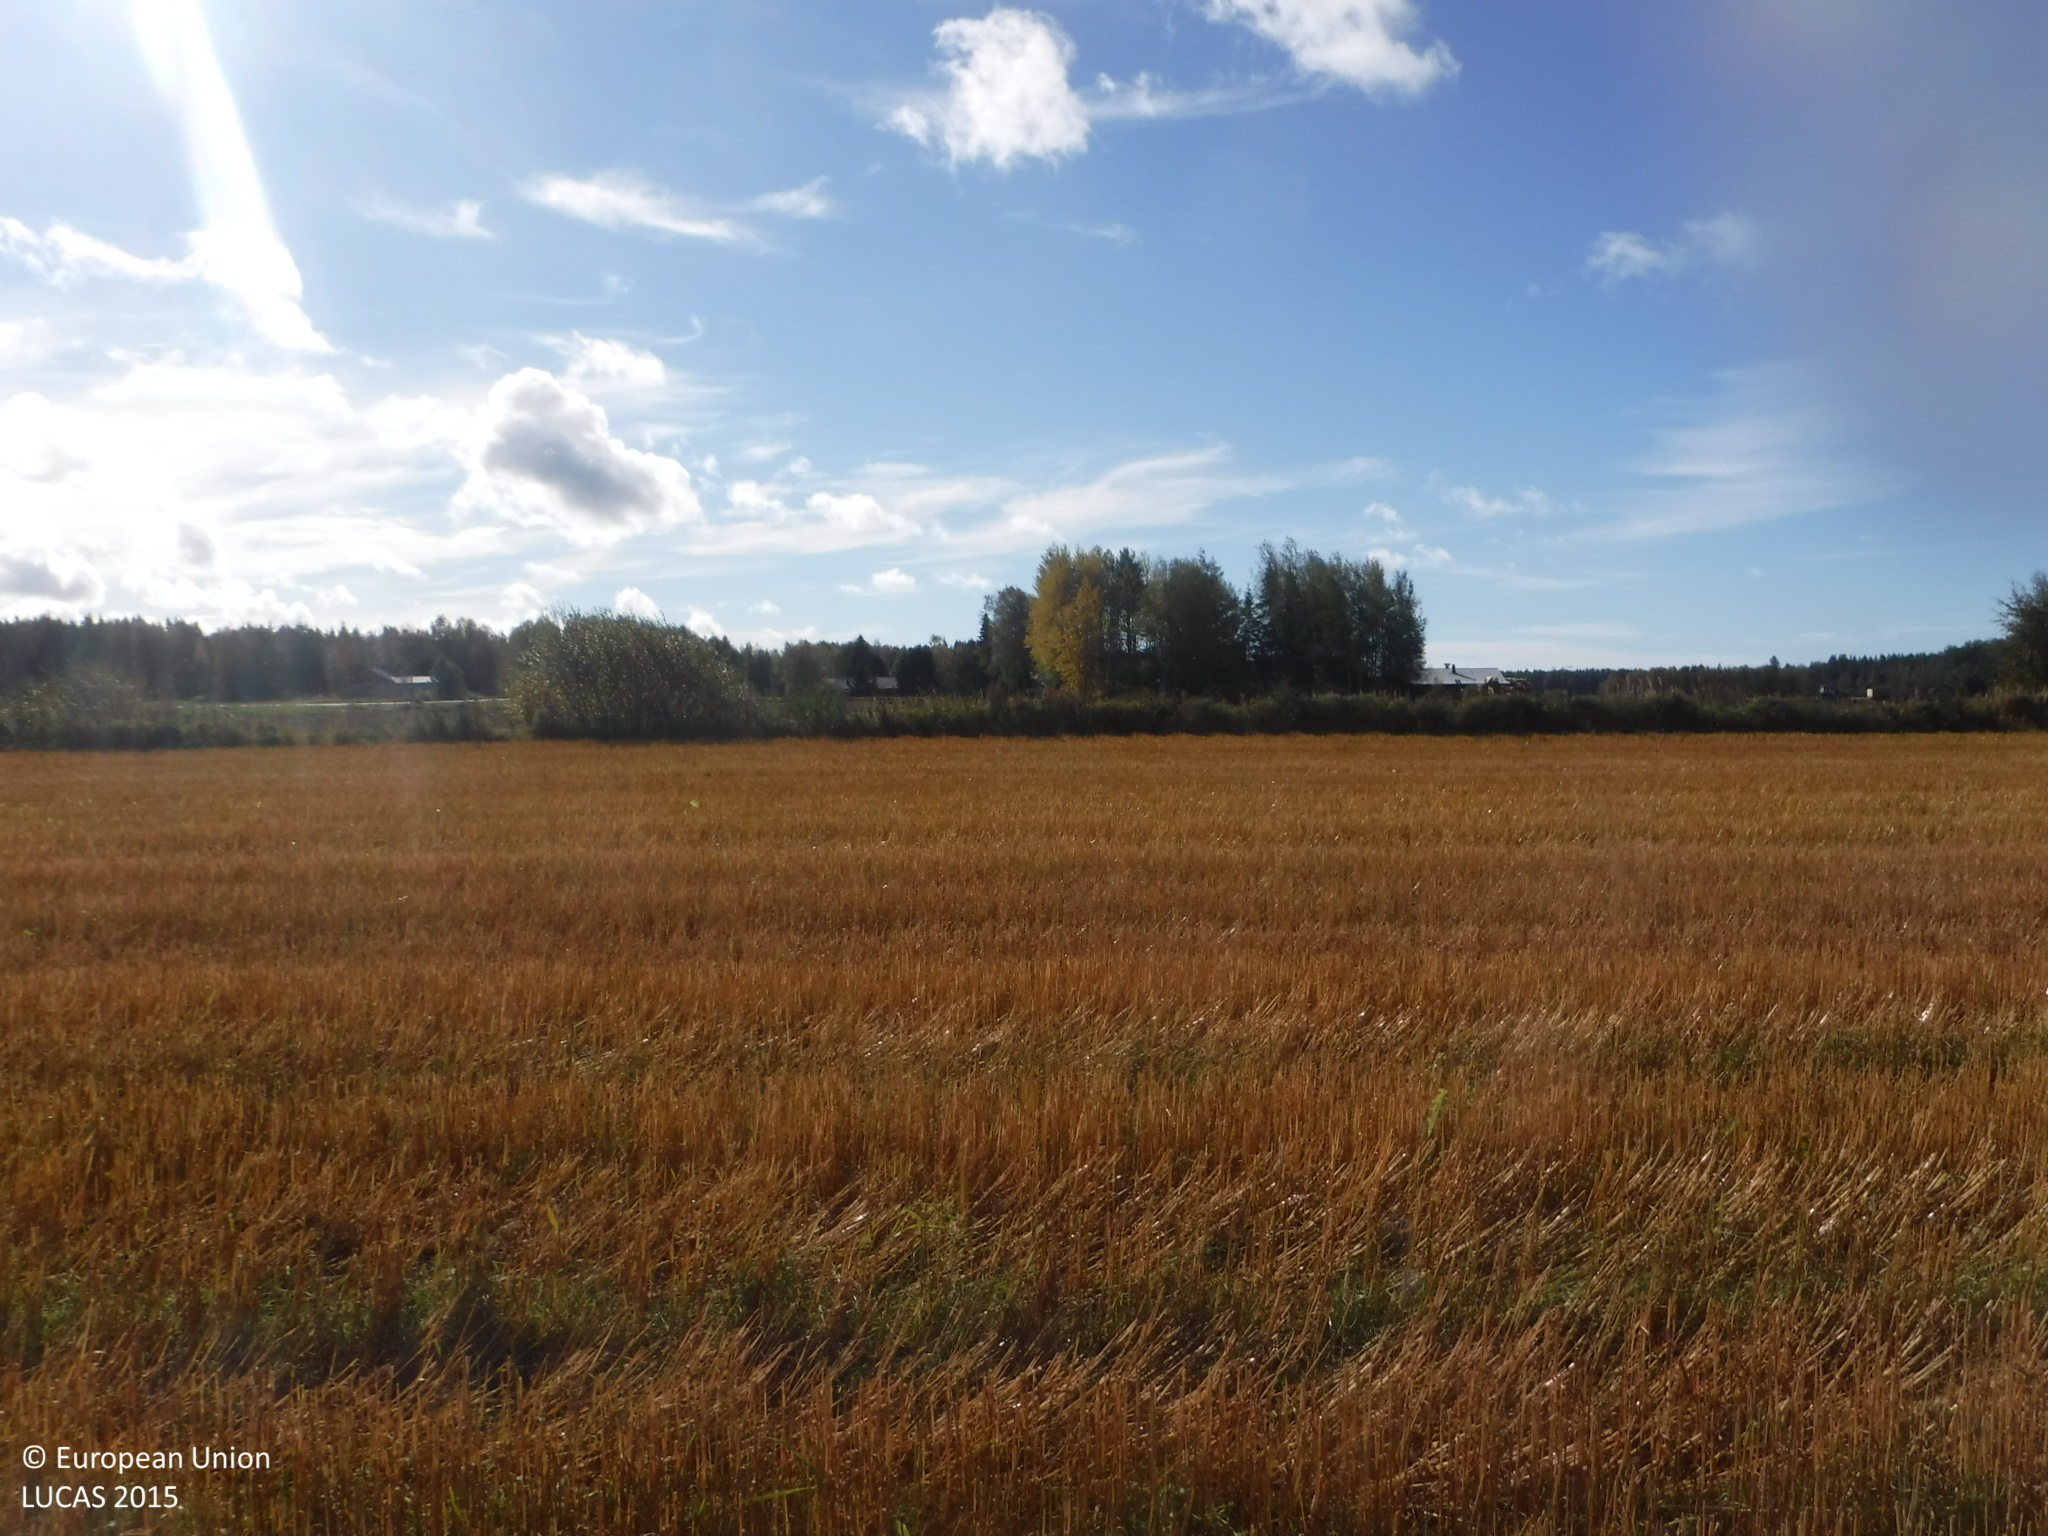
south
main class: Cropland
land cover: Oats
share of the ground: 50 - 75 %
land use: Agriculture (excluding fallow land and kitchen gardens)
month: September
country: FI
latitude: 62.1135
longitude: 21.5264
